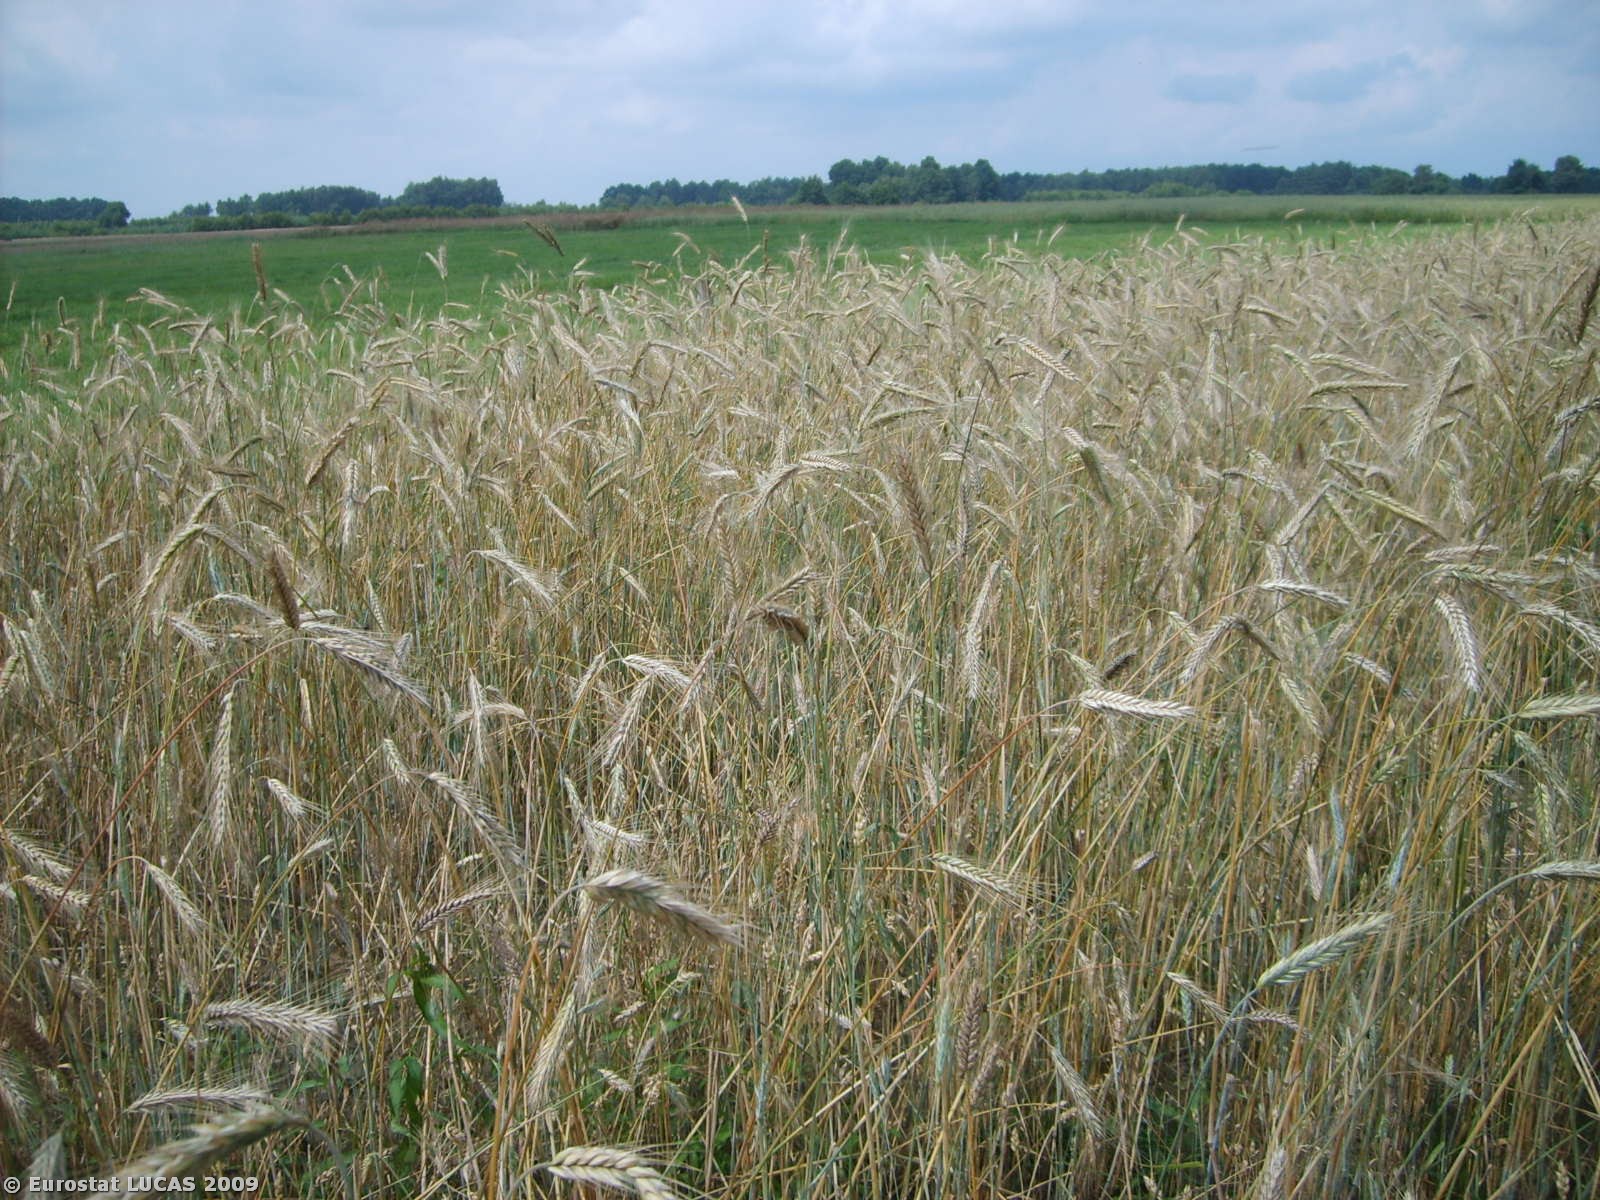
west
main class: Cropland
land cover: Rye
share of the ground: > 75 %
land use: Agriculture (excluding fallow land and kitchen gardens)
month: July
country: PL
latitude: 52.1242
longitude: 21.6951
